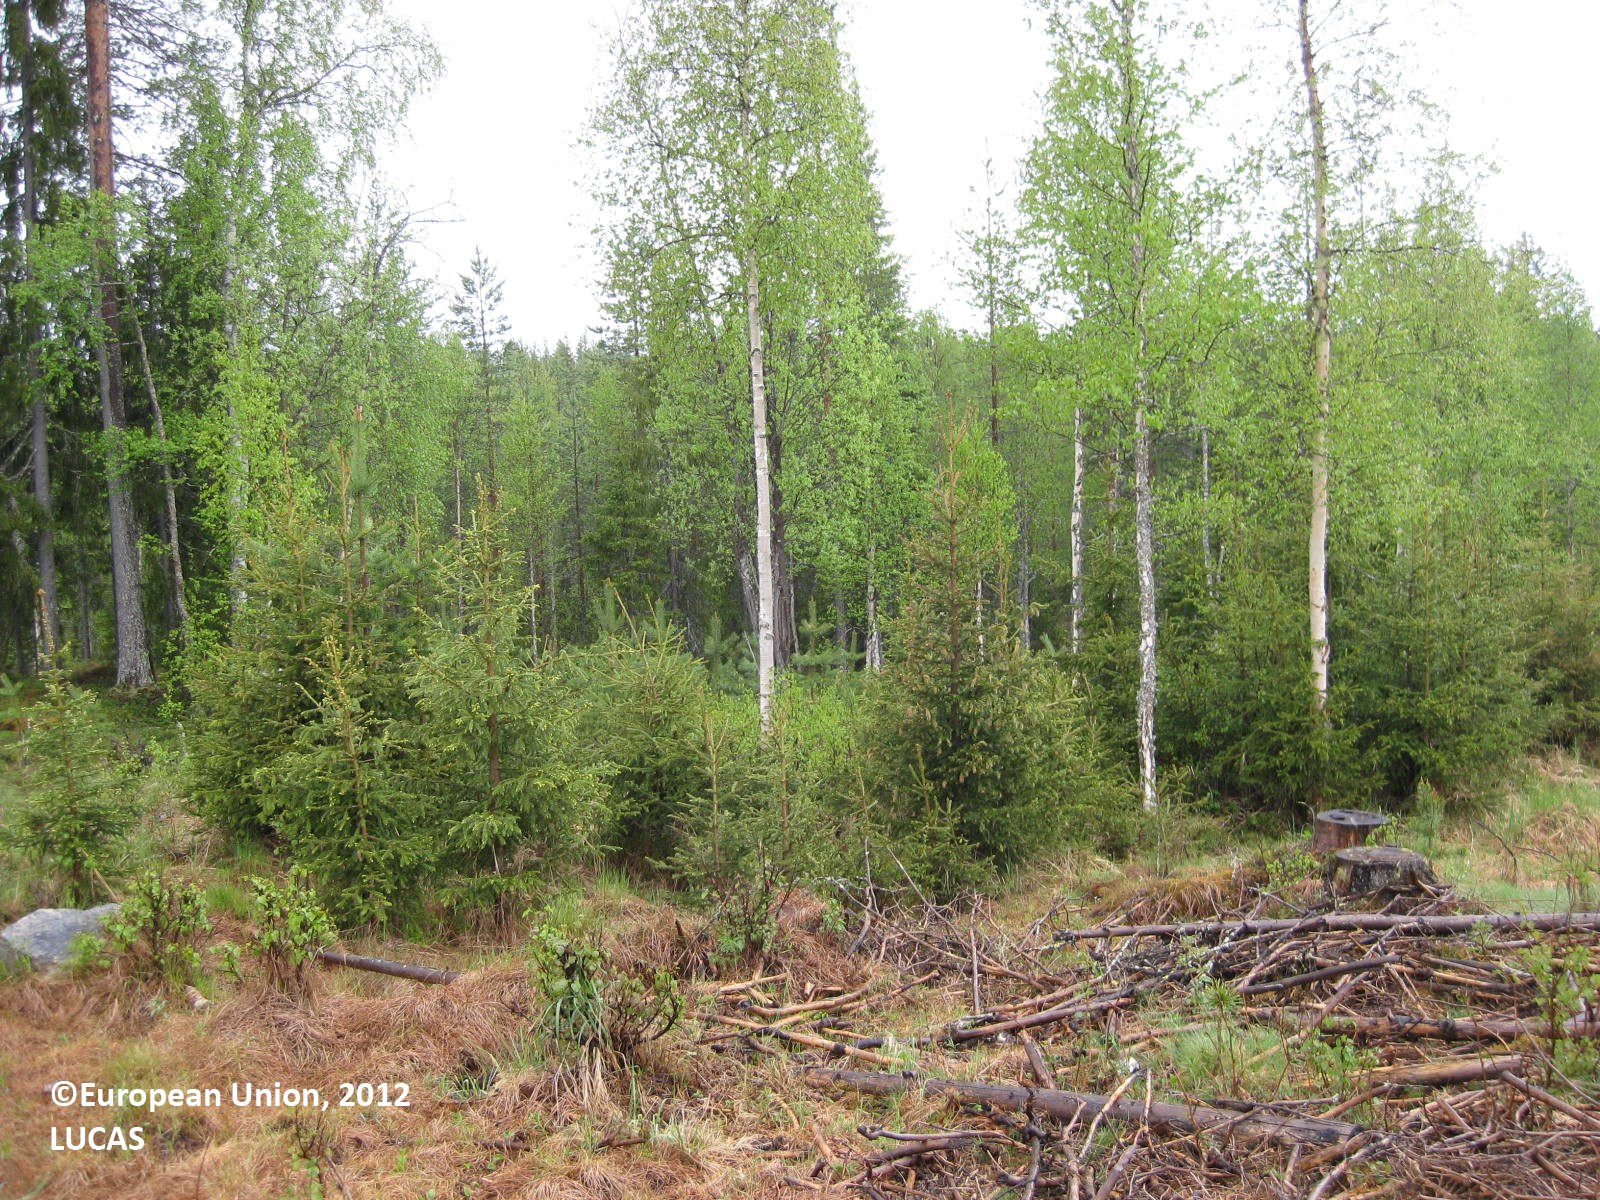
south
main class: Woodland
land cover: Pine dominated coniferous woodland
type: boreal forest
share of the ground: 50 - 75 %
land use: Forestry
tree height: < 5 m
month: June
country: FI
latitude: 65.1945
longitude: 29.4927
